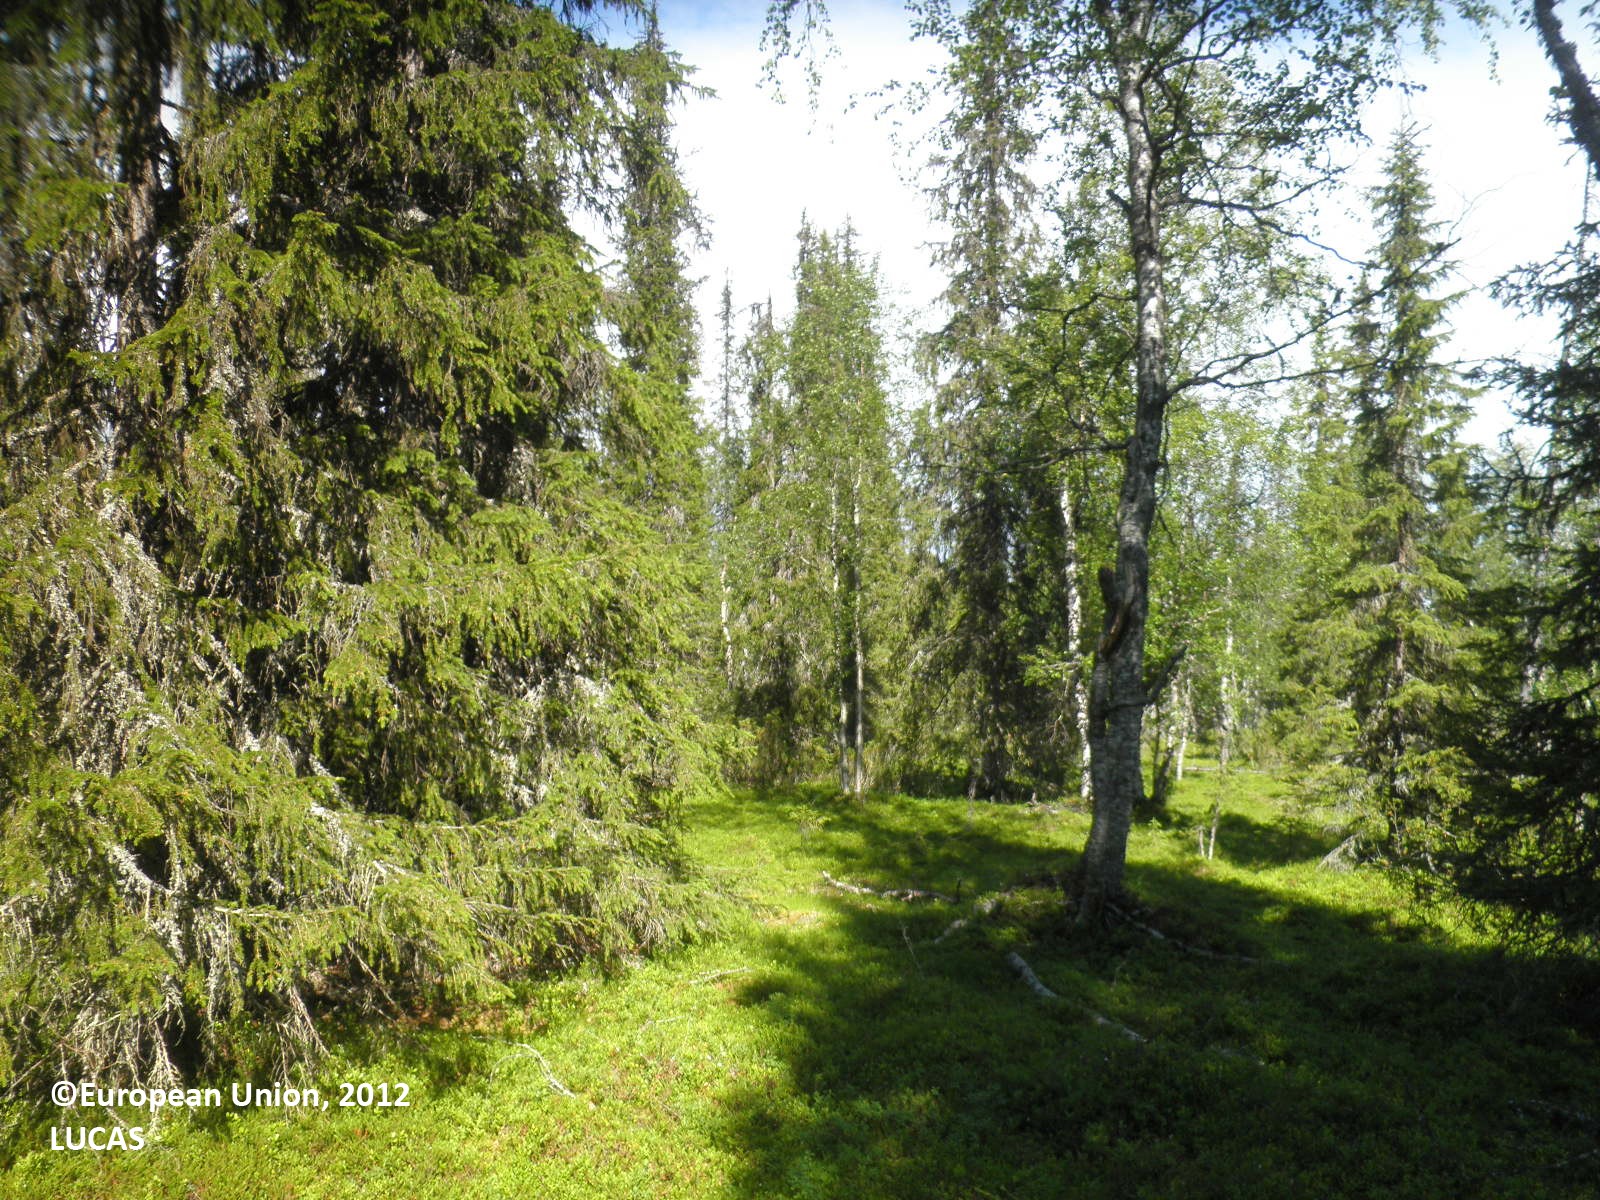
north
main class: Woodland
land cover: Spruce dominated mixed woodland
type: boreal forest
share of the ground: 50 - 75 %
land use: Forestry
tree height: > 5 m
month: July
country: FI
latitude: 67.9263
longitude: 26.1516
